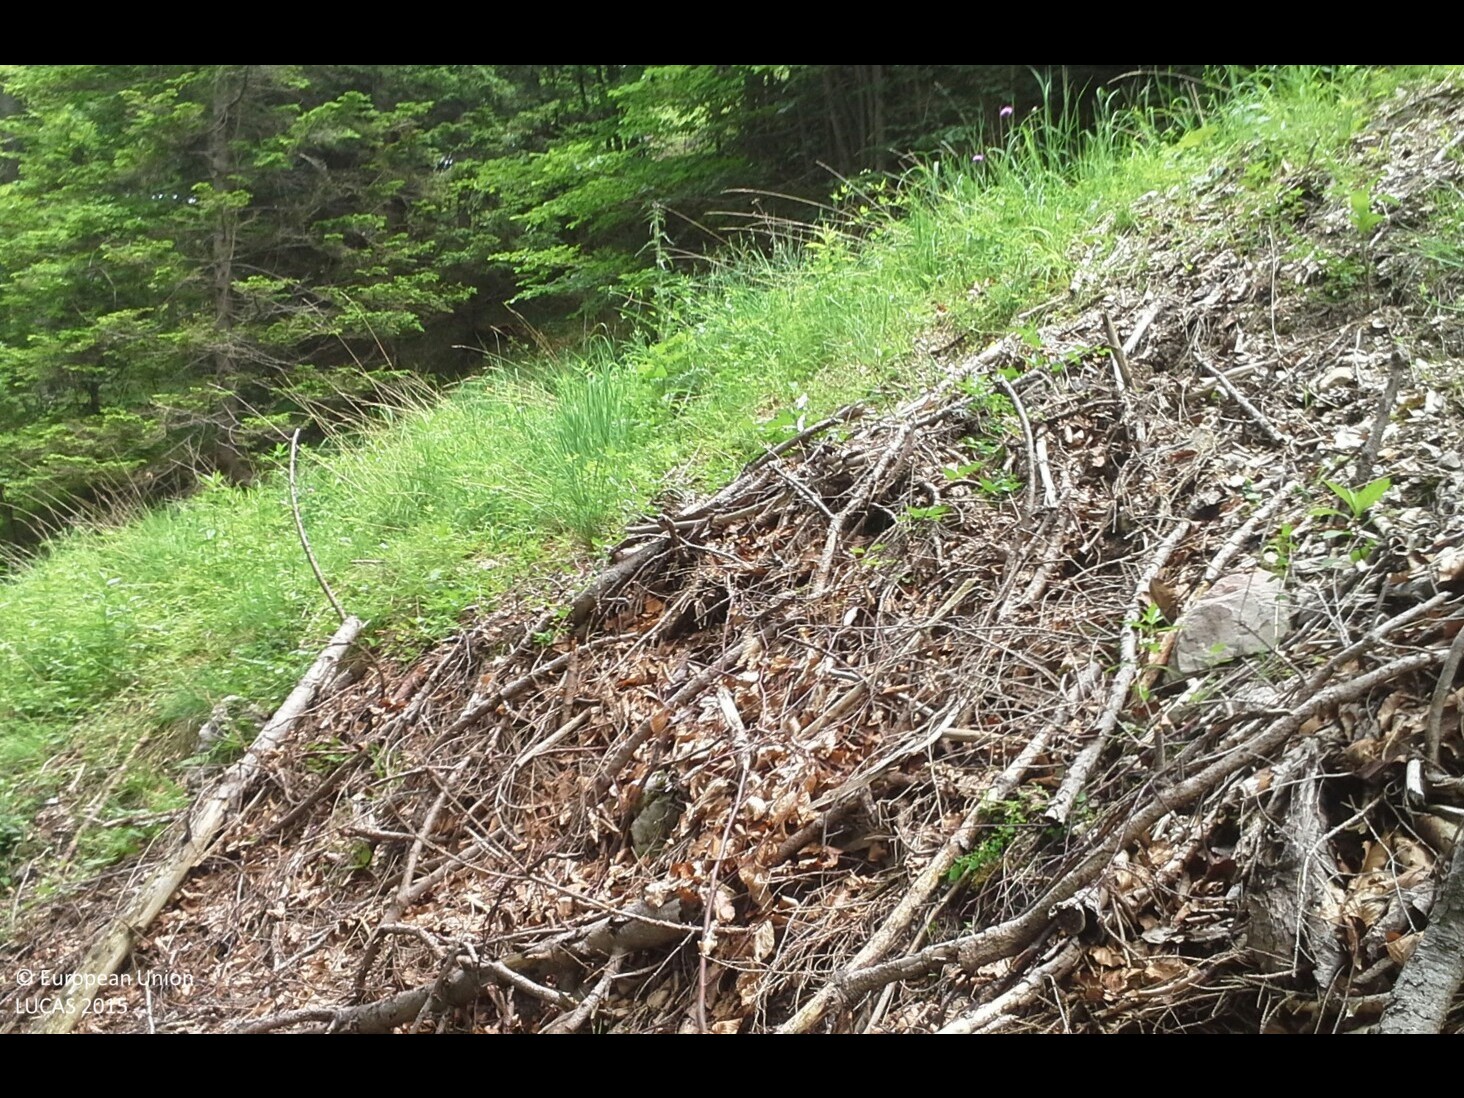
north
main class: Woodland
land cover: Spruce dominated mixed woodland
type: beech forest
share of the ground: > 75 %
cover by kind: broadleaved forest trees 60 %, coniferous forest trees 25 %, herbaceous plants 10 %, unconsolidated bare surface 5 %
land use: Forestry
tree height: > 5 m
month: June
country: AT
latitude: 47.7626
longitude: 13.7746
